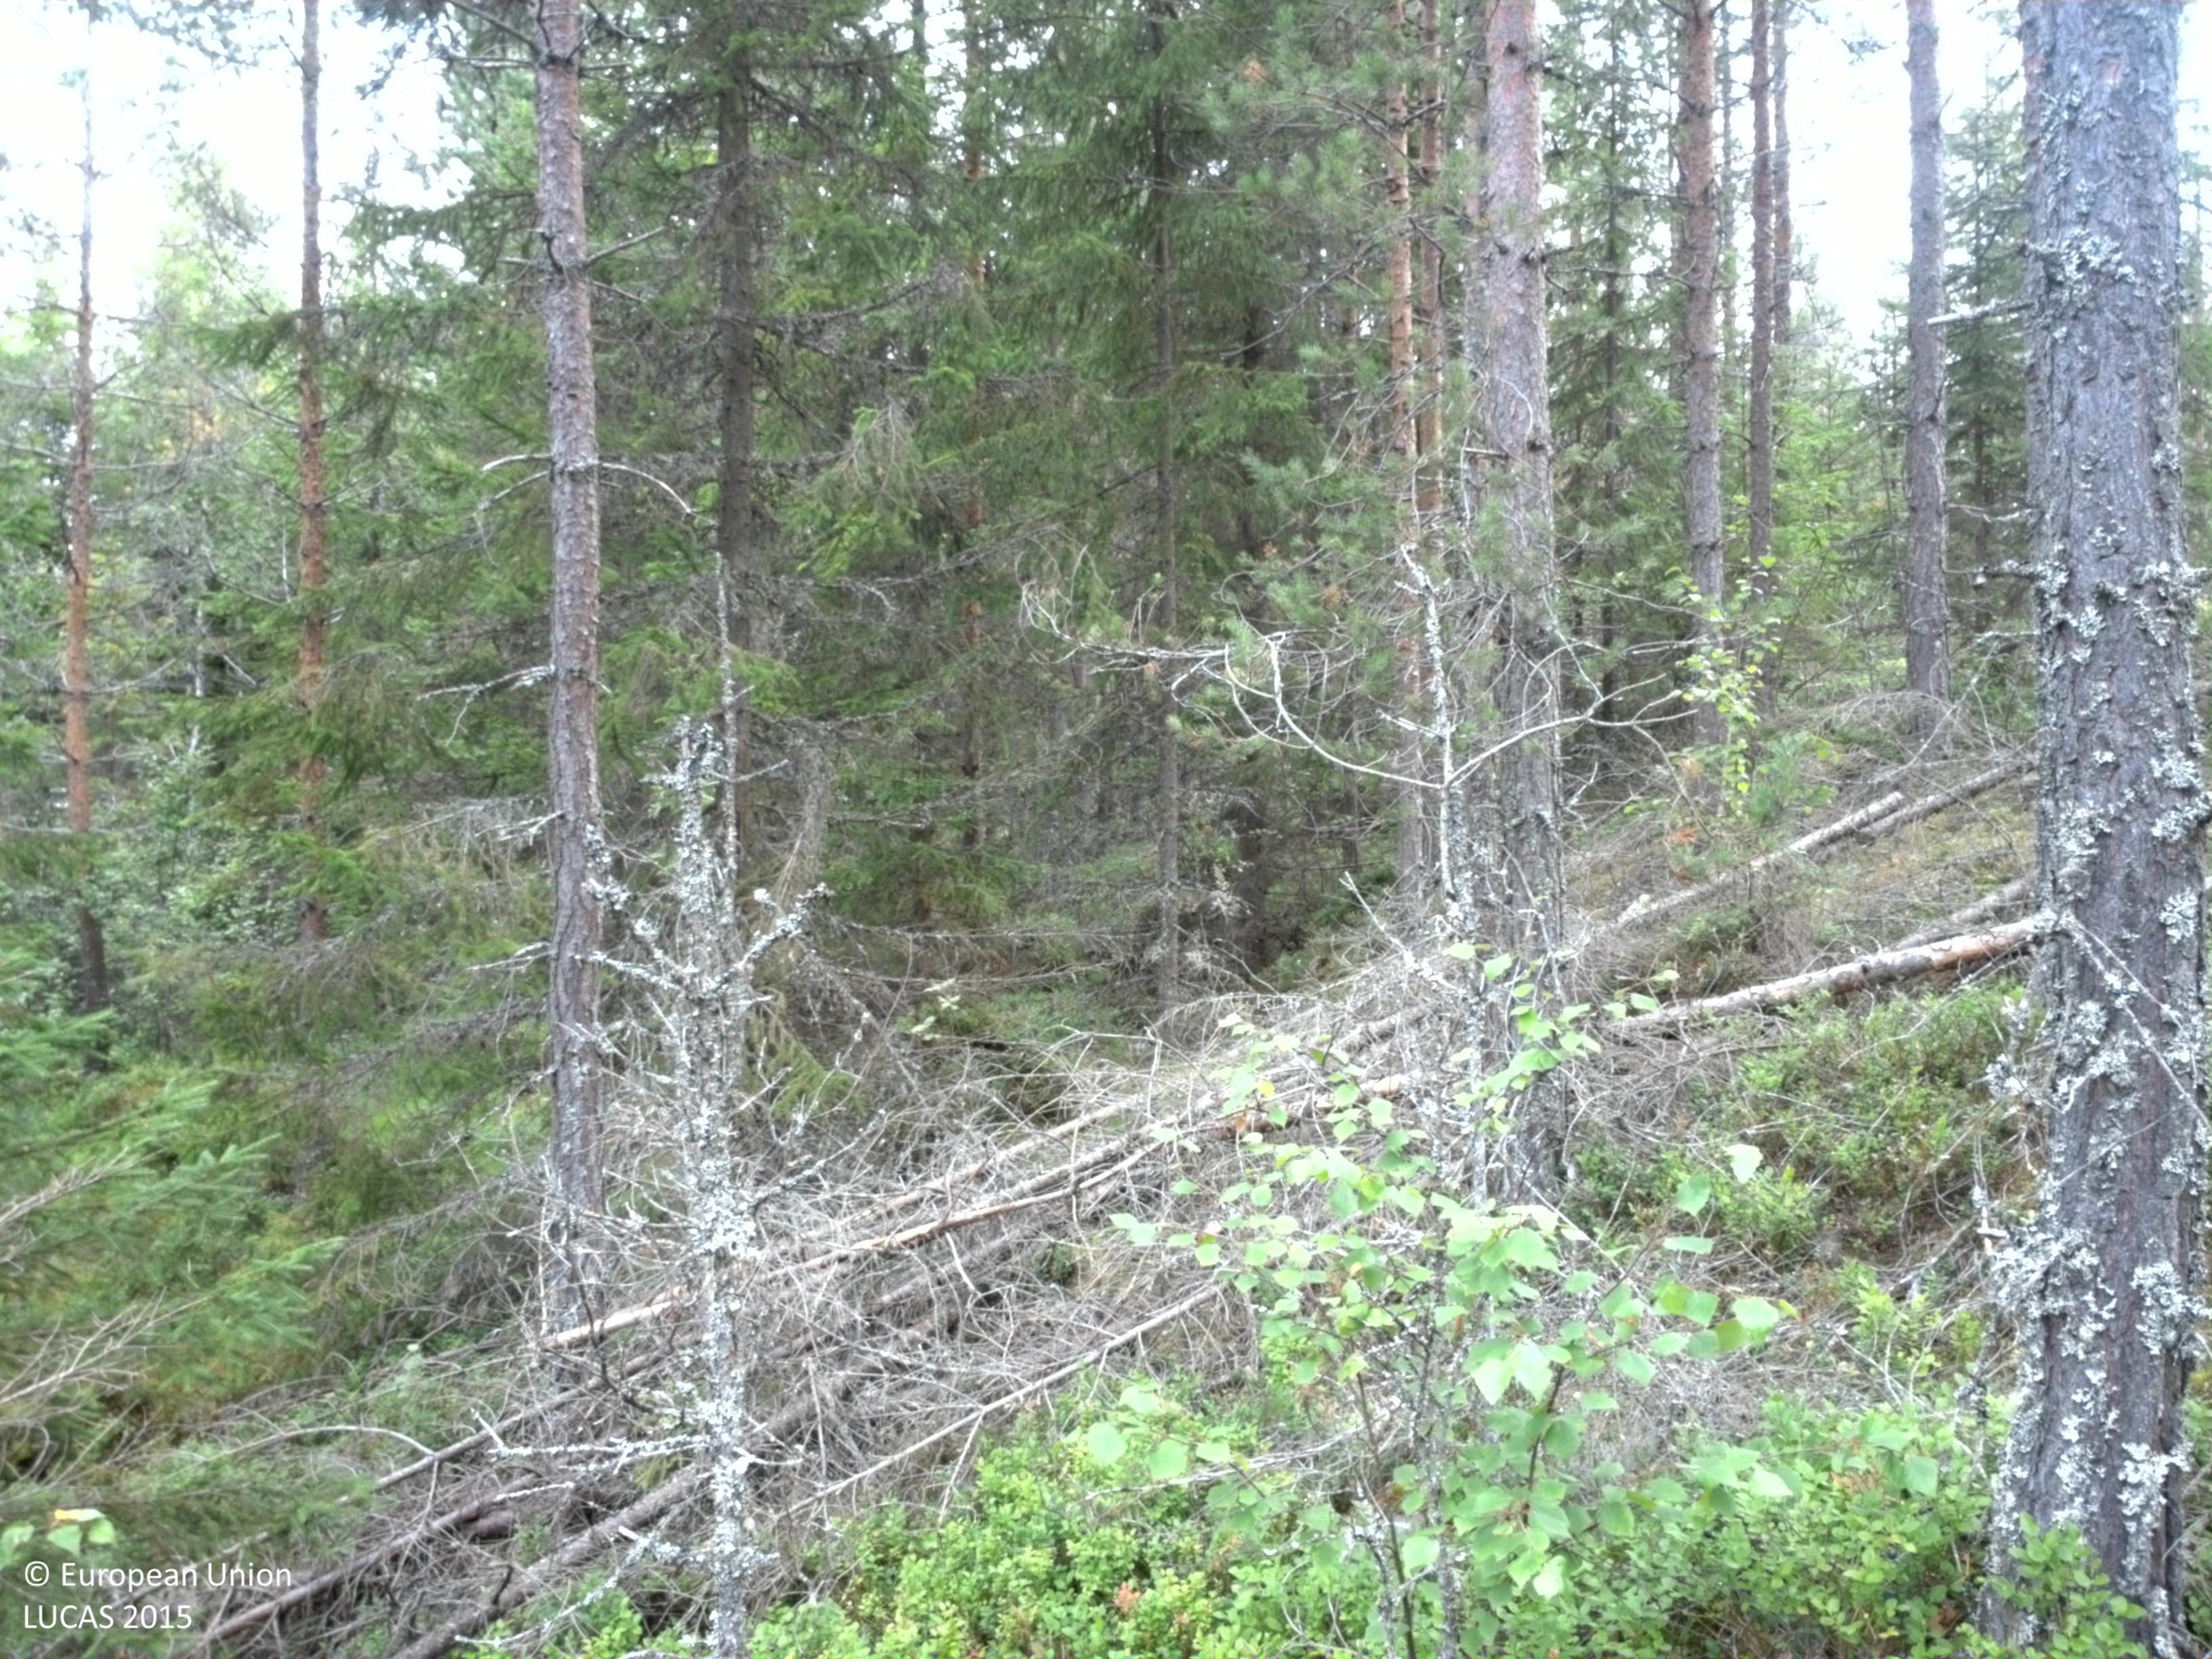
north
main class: Woodland
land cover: Pine dominated coniferous woodland
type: boreal forest
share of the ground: 50 - 75 %
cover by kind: coniferous forest trees 55 %, shrubs 25 %, lichens and mosses 20 %
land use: Forestry
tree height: > 5 m
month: August
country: SE
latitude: 60.0140
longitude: 13.3812
